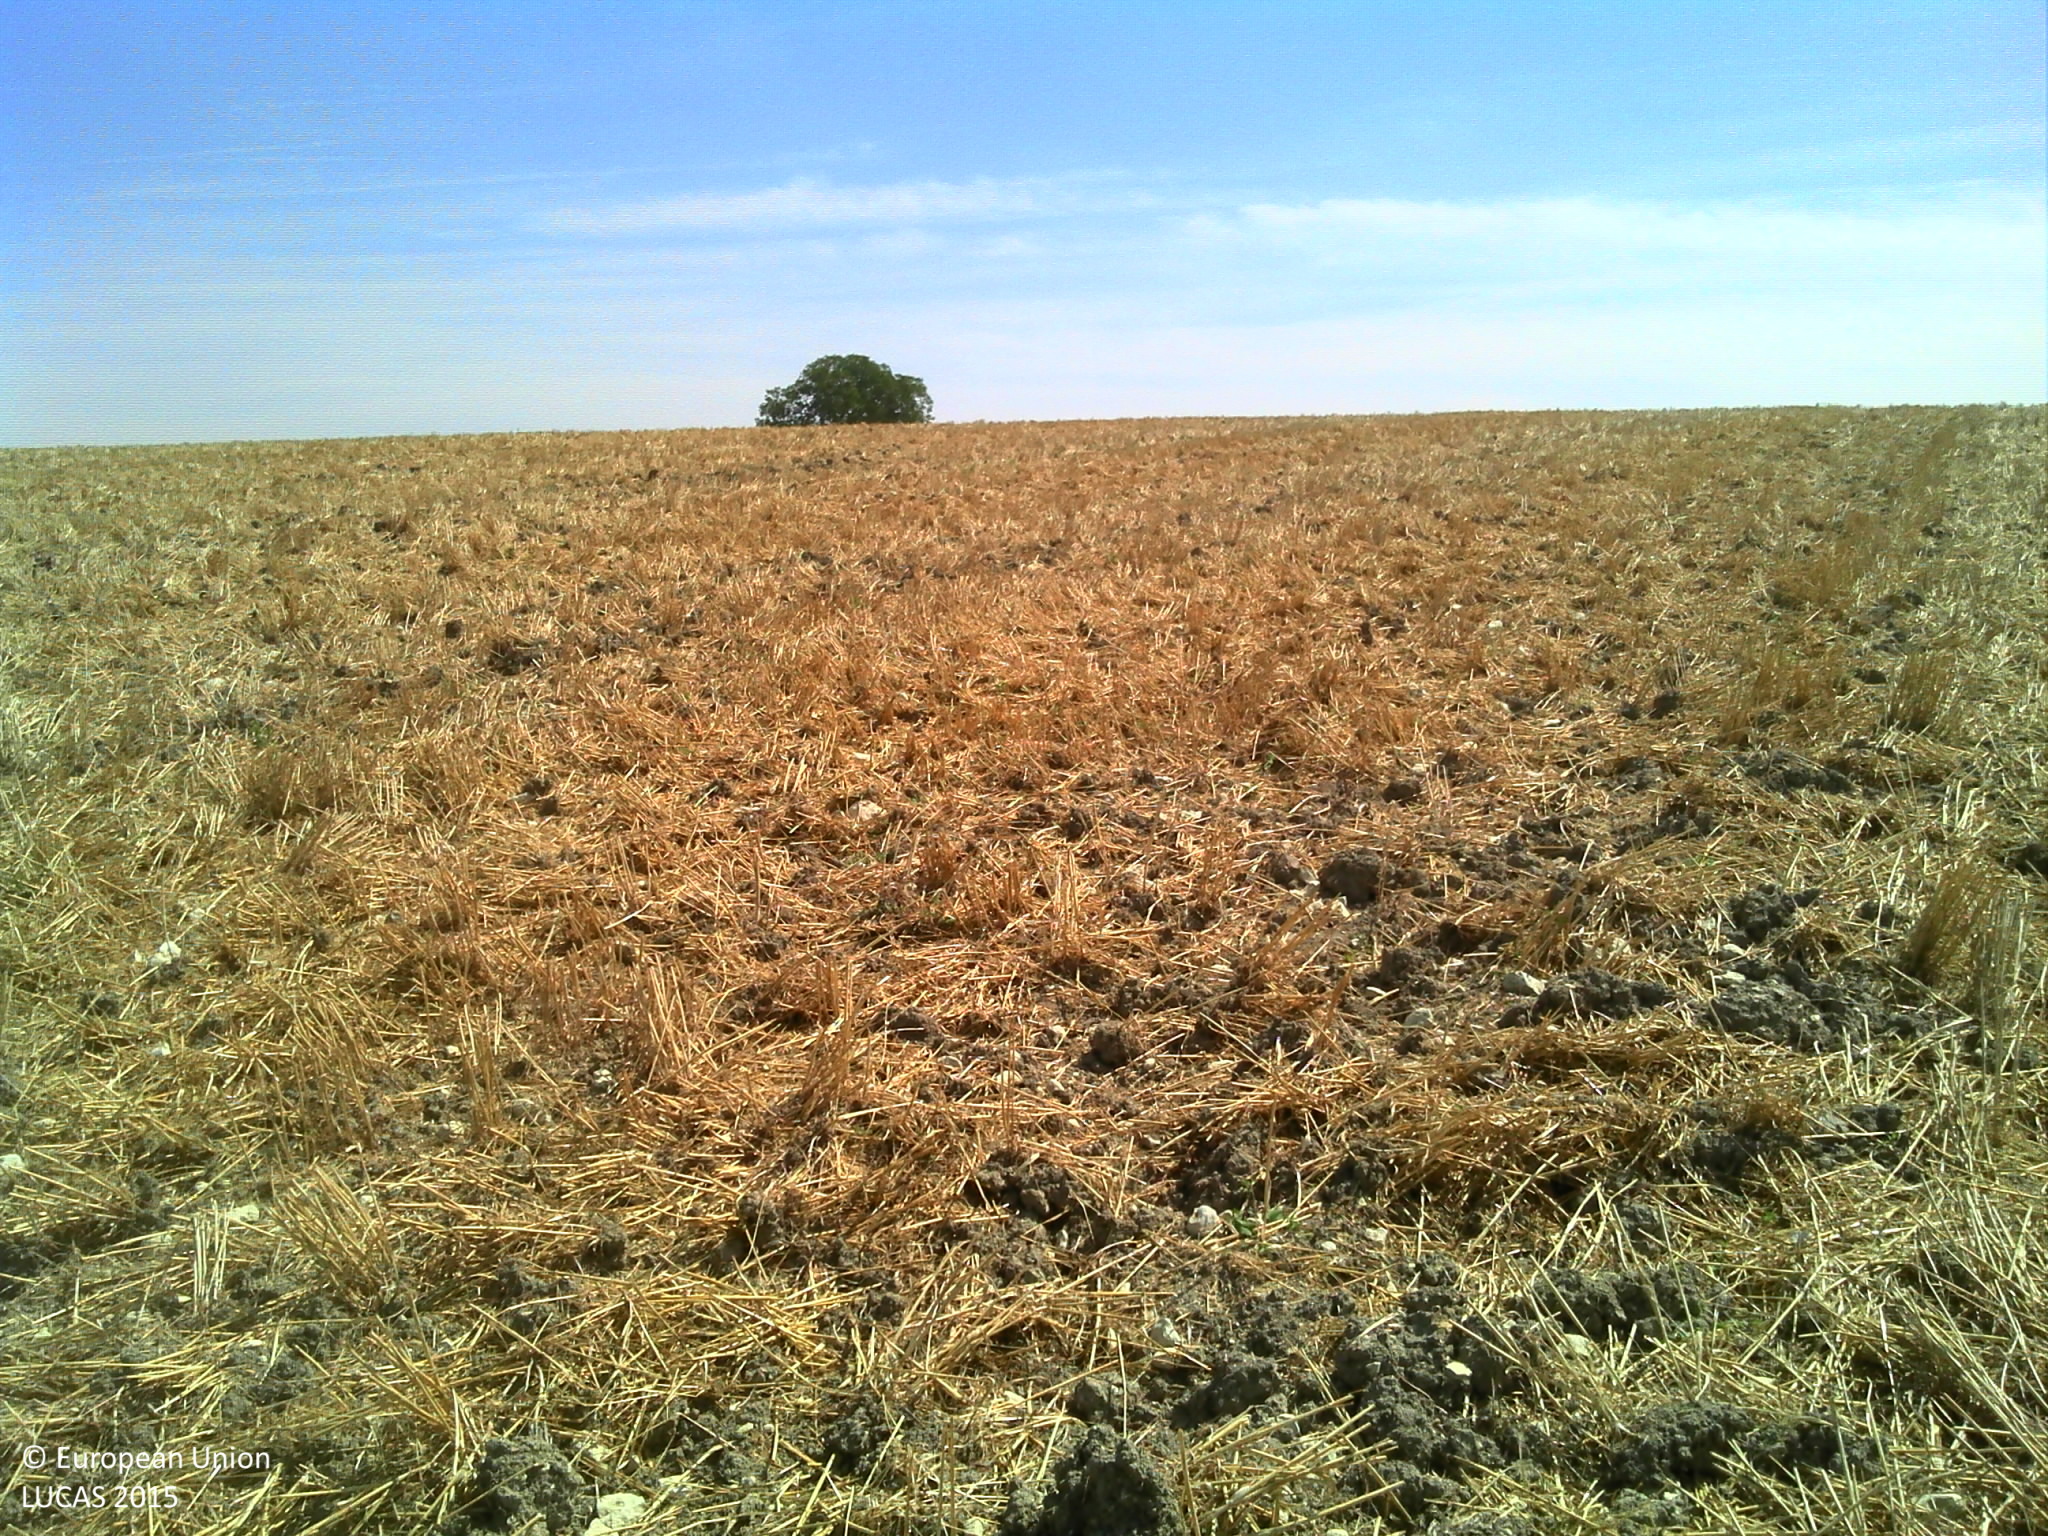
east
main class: Cropland
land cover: Common wheat
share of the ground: > 75 %
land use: Agriculture (excluding fallow land and kitchen gardens)
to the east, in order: Common wheat; Grass margins; Ditches and canals; Grass margins; Paved roads, cycling and walking lanes; Grass margins; Ditches and canals; Grass margins; Common wheat
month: July
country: FR
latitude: 47.0792
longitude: 0.4044
